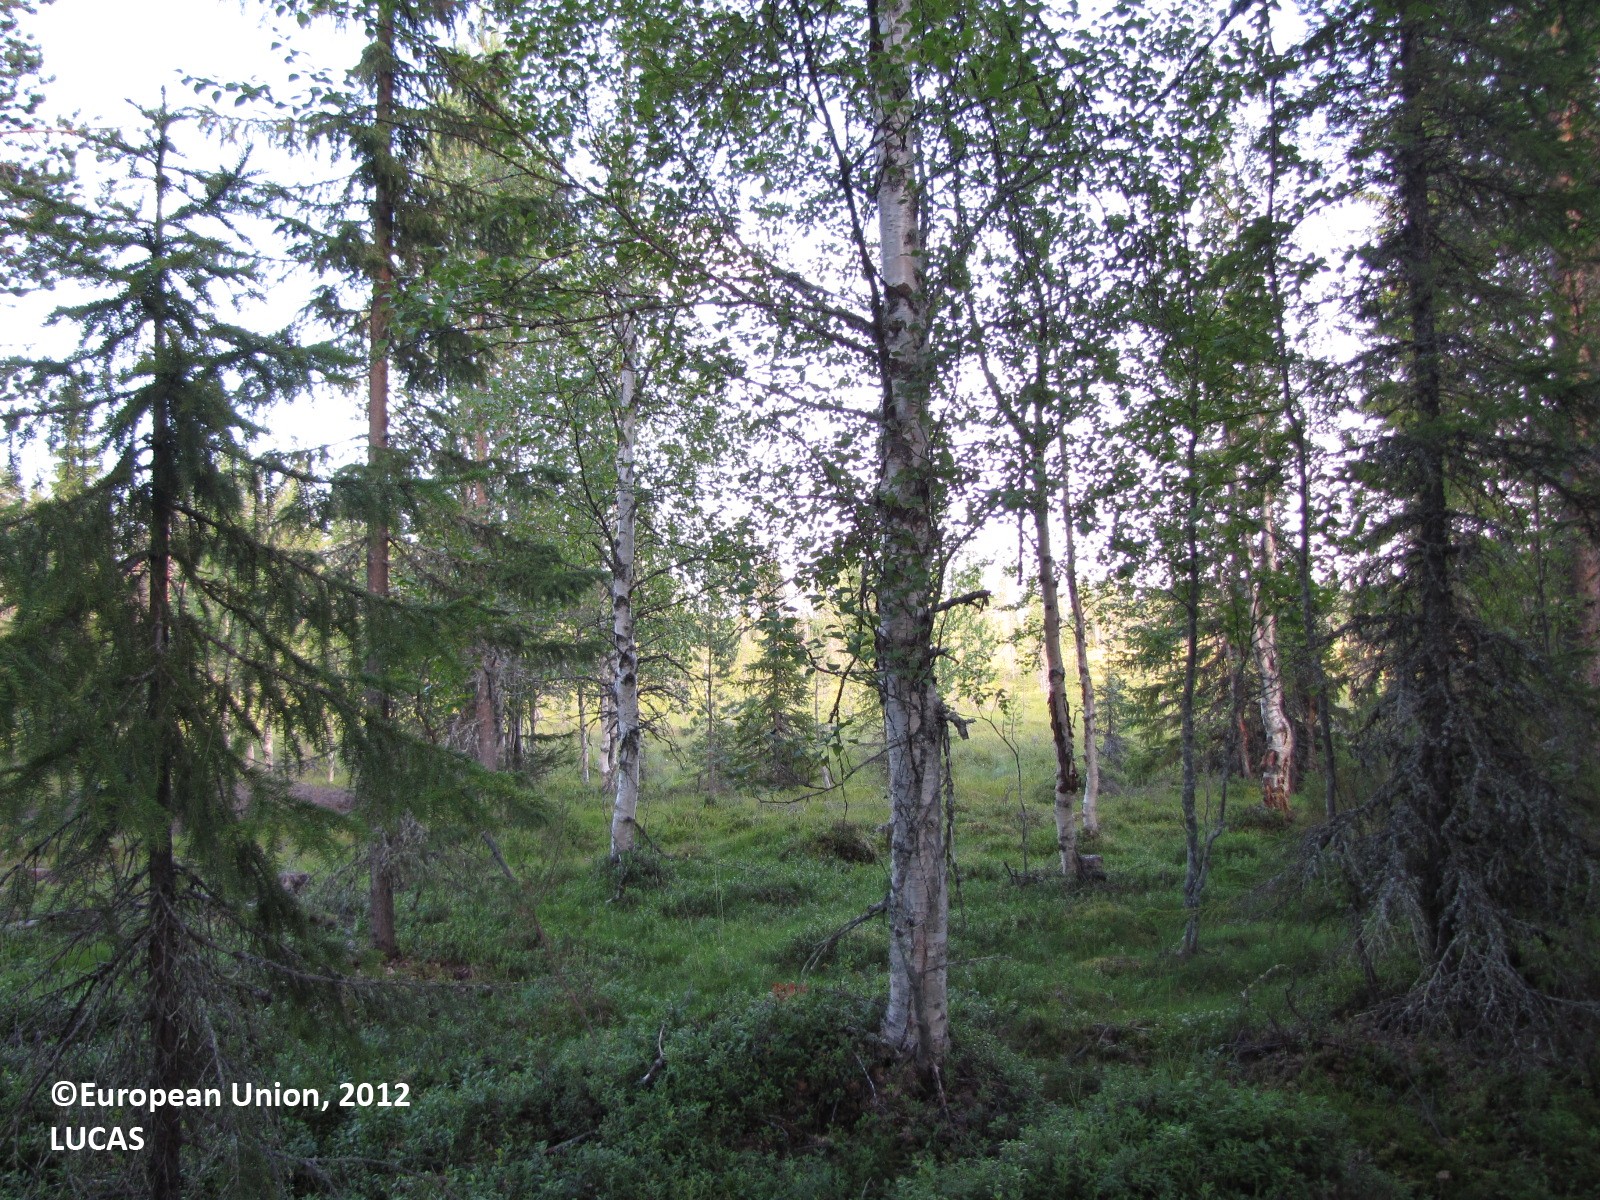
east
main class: Woodland
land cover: Spruce dominated mixed woodland
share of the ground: 25 - 50 %
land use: Forestry
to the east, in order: Spruce dominated mixed woodland; Peatbogs; Pine dominated coniferous woodland; Pine dominated mixed woodland
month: August
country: FI
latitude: 66.8040
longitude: 24.9973
